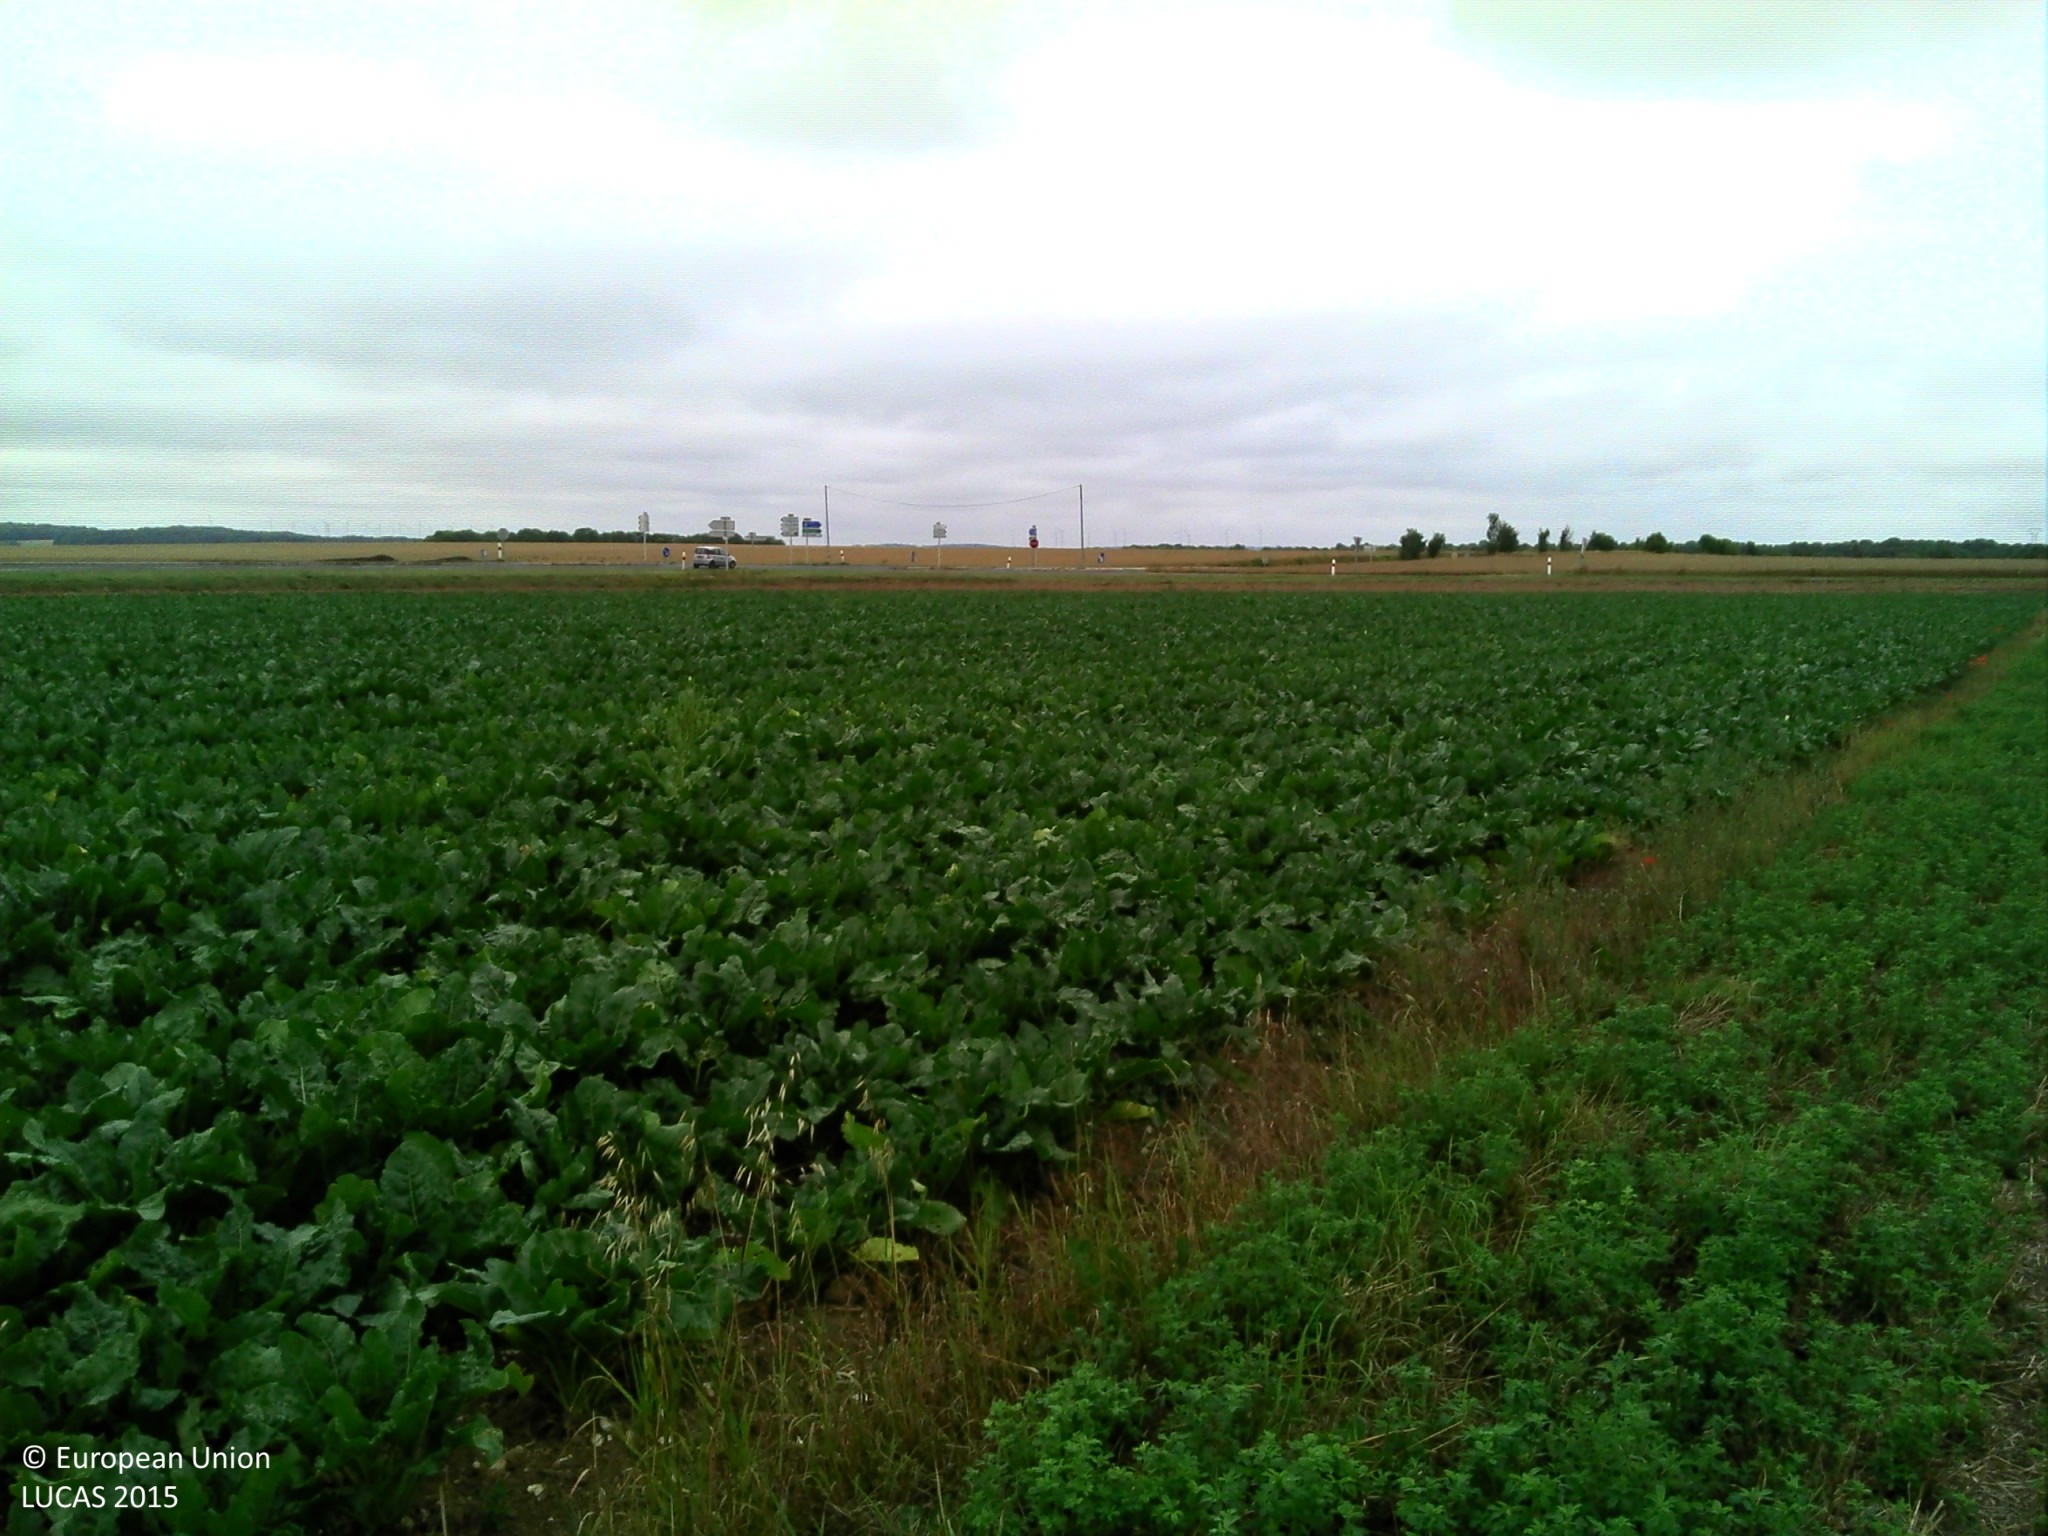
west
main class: Cropland
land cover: Lucerne
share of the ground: > 75 %
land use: Agriculture (excluding fallow land and kitchen gardens)
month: July
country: FR
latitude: 49.9685
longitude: 2.1642
